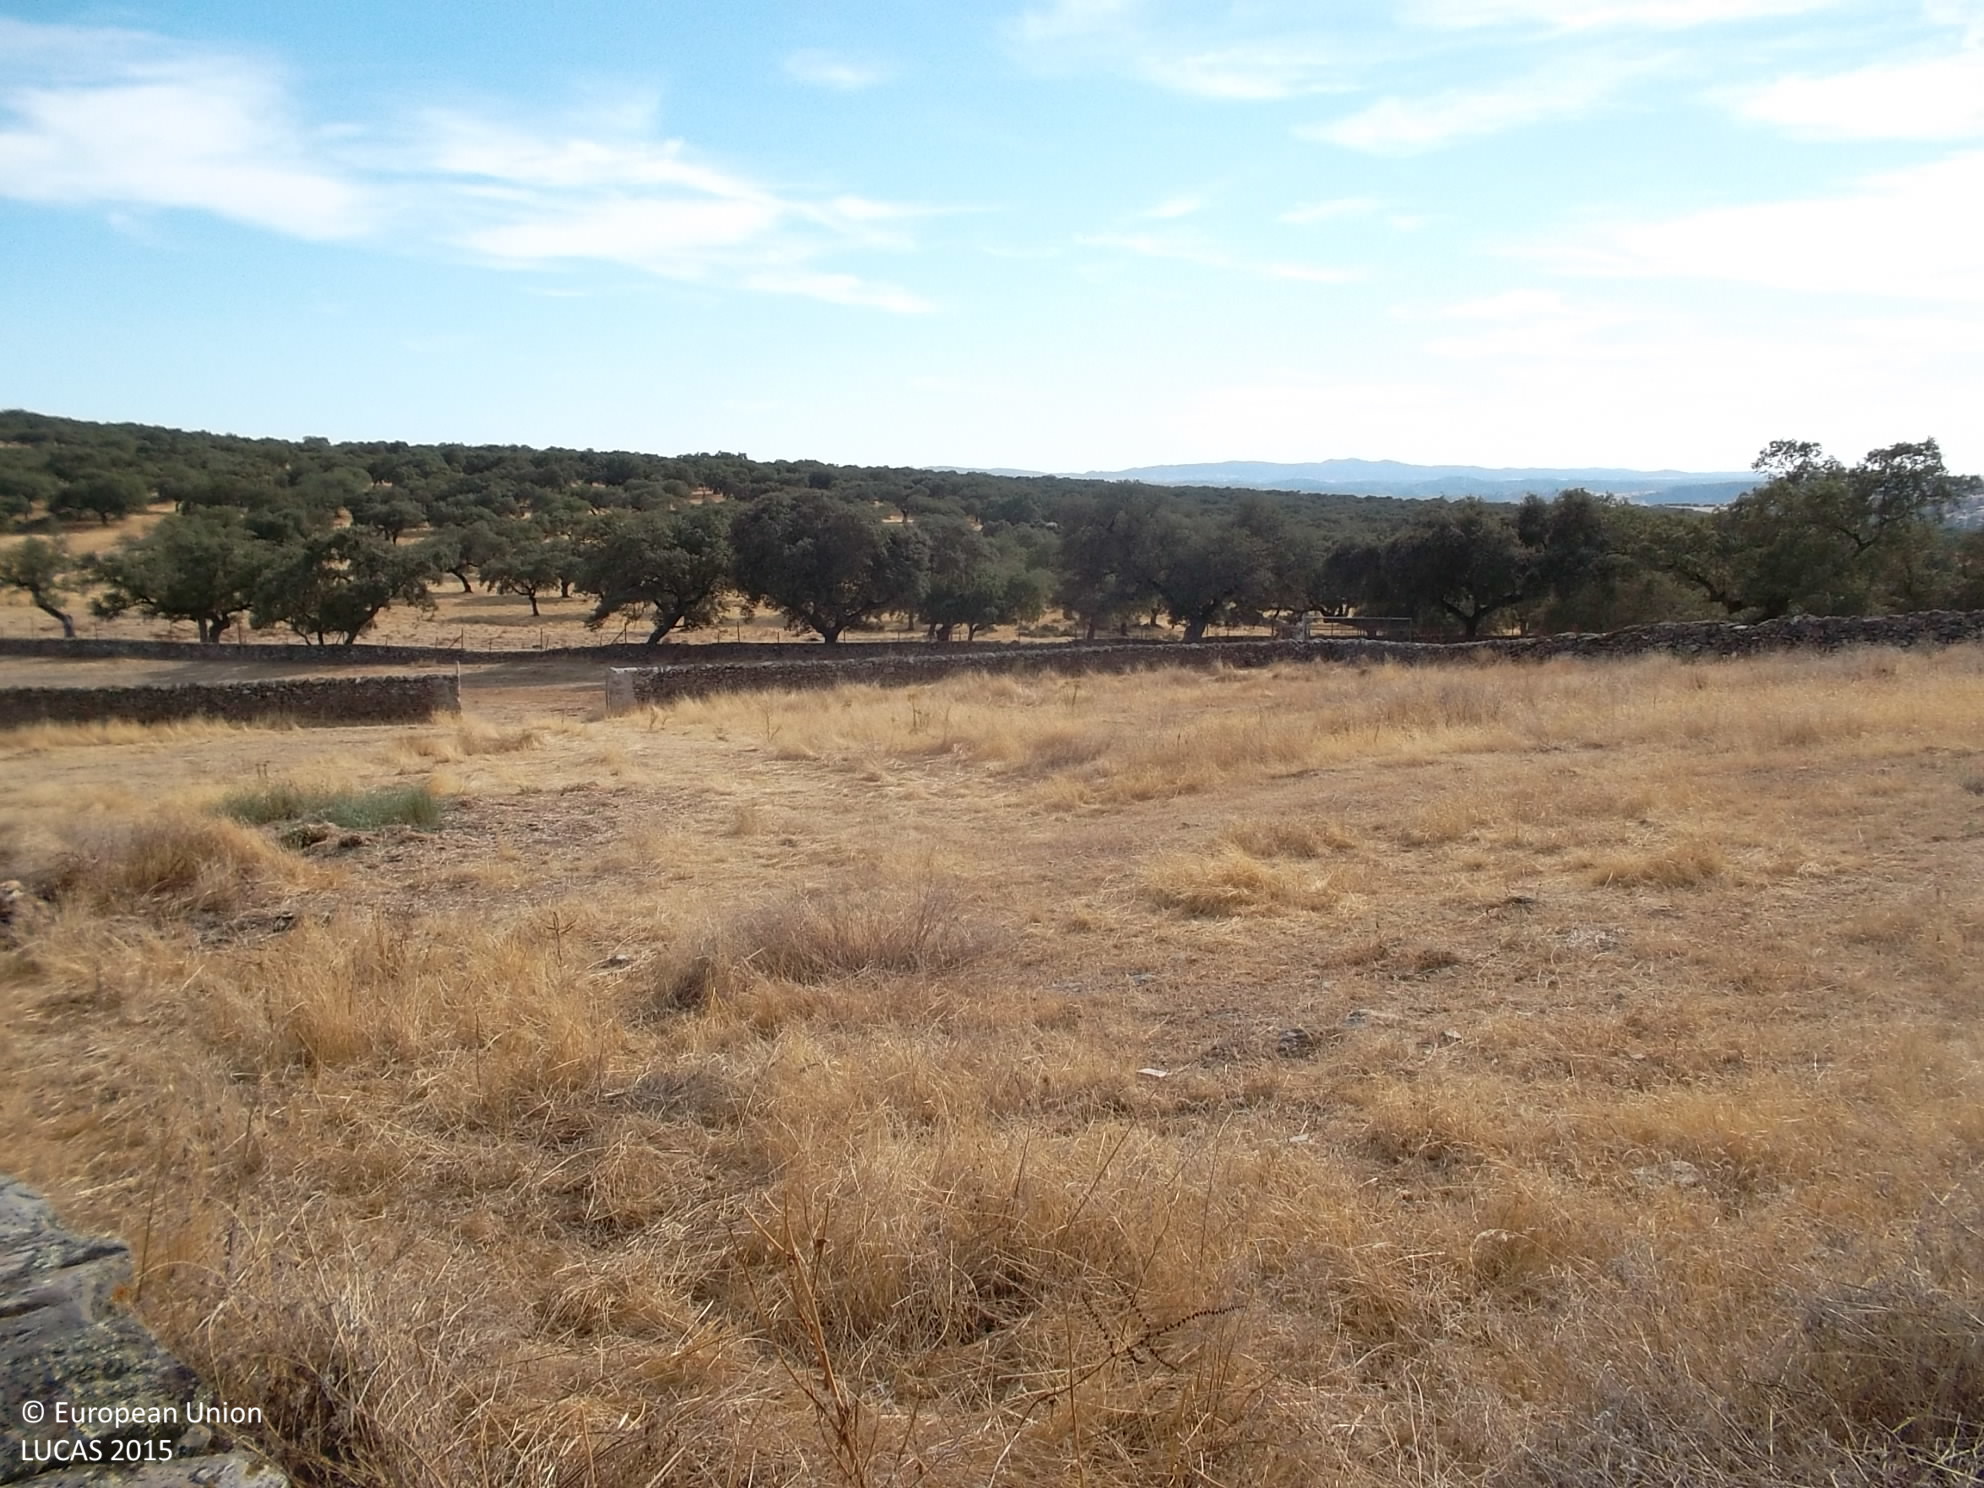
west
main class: Grassland
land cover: Grassland without tree/shrub cover
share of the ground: > 75 %
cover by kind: herbaceous plants 100 %
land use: Agriculture (excluding fallow land and kitchen gardens)
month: August
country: ES
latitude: 38.1444
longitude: -6.7916
